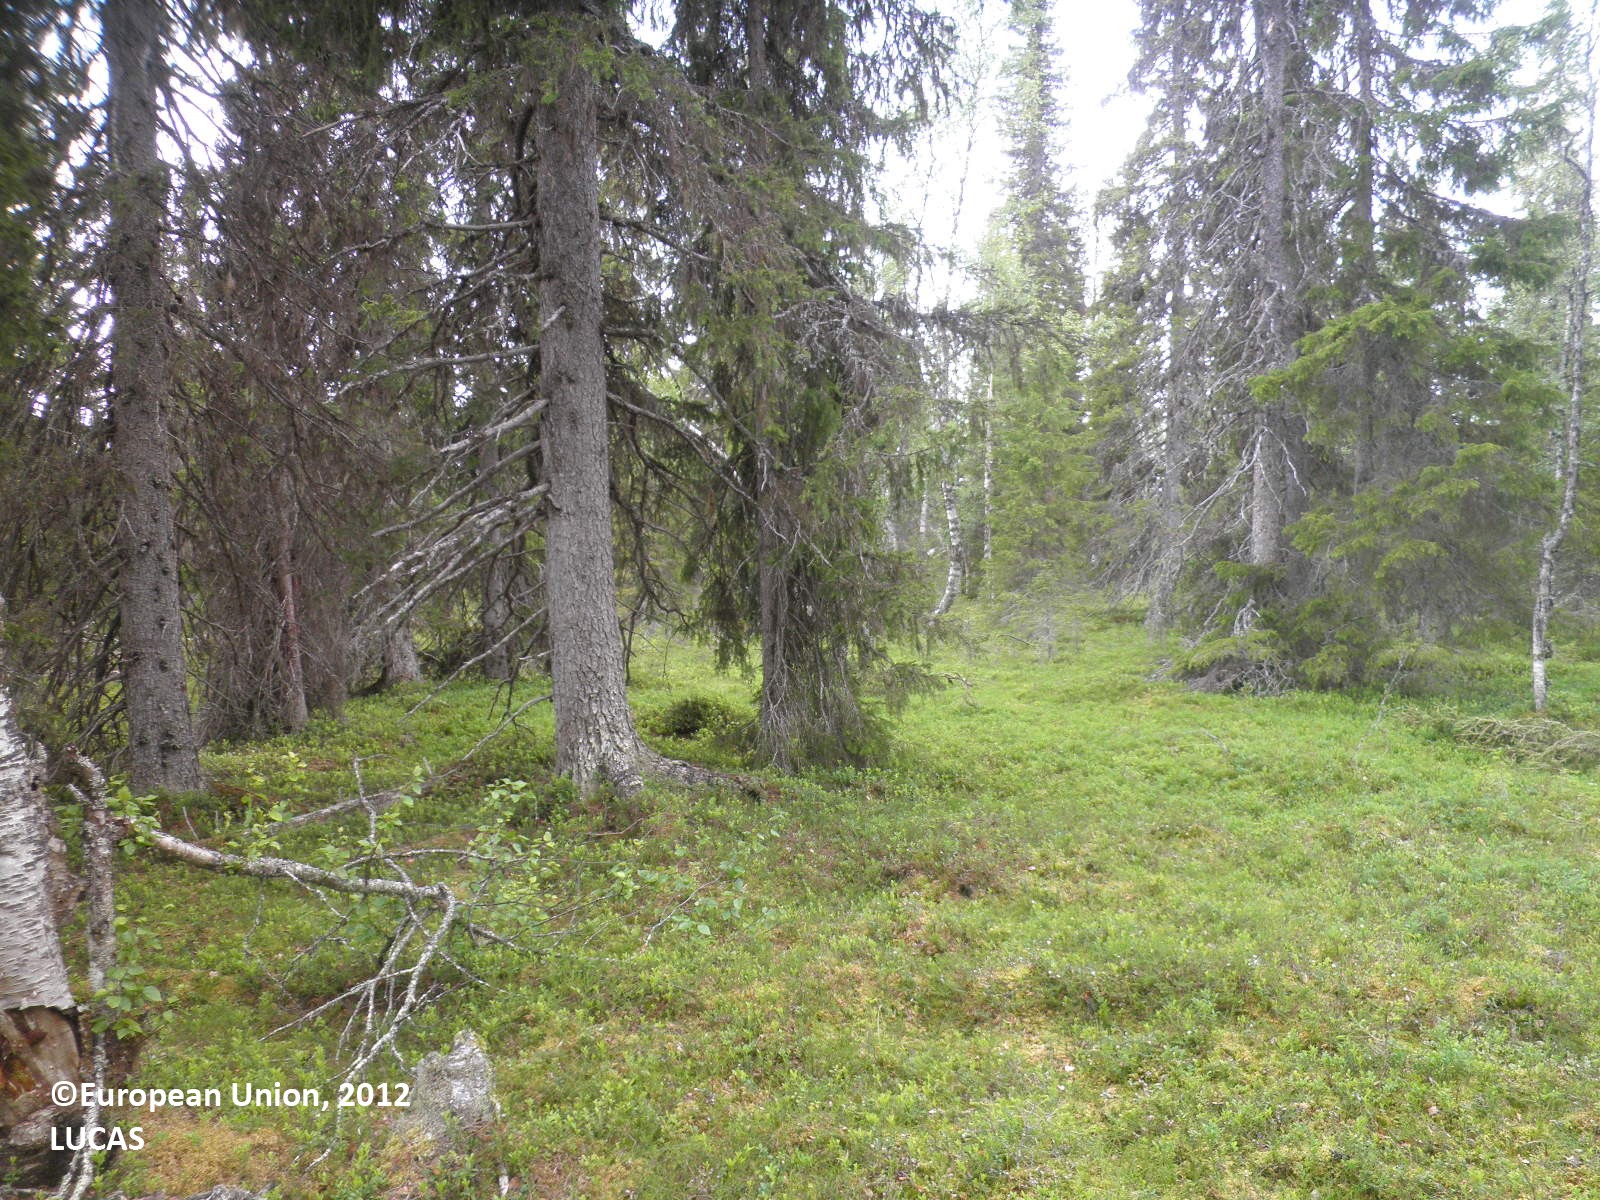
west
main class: Woodland
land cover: Spruce dominated mixed woodland
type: boreal forest
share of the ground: 50 - 75 %
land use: Forestry
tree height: > 5 m
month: July
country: FI
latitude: 67.9613
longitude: 26.1758
